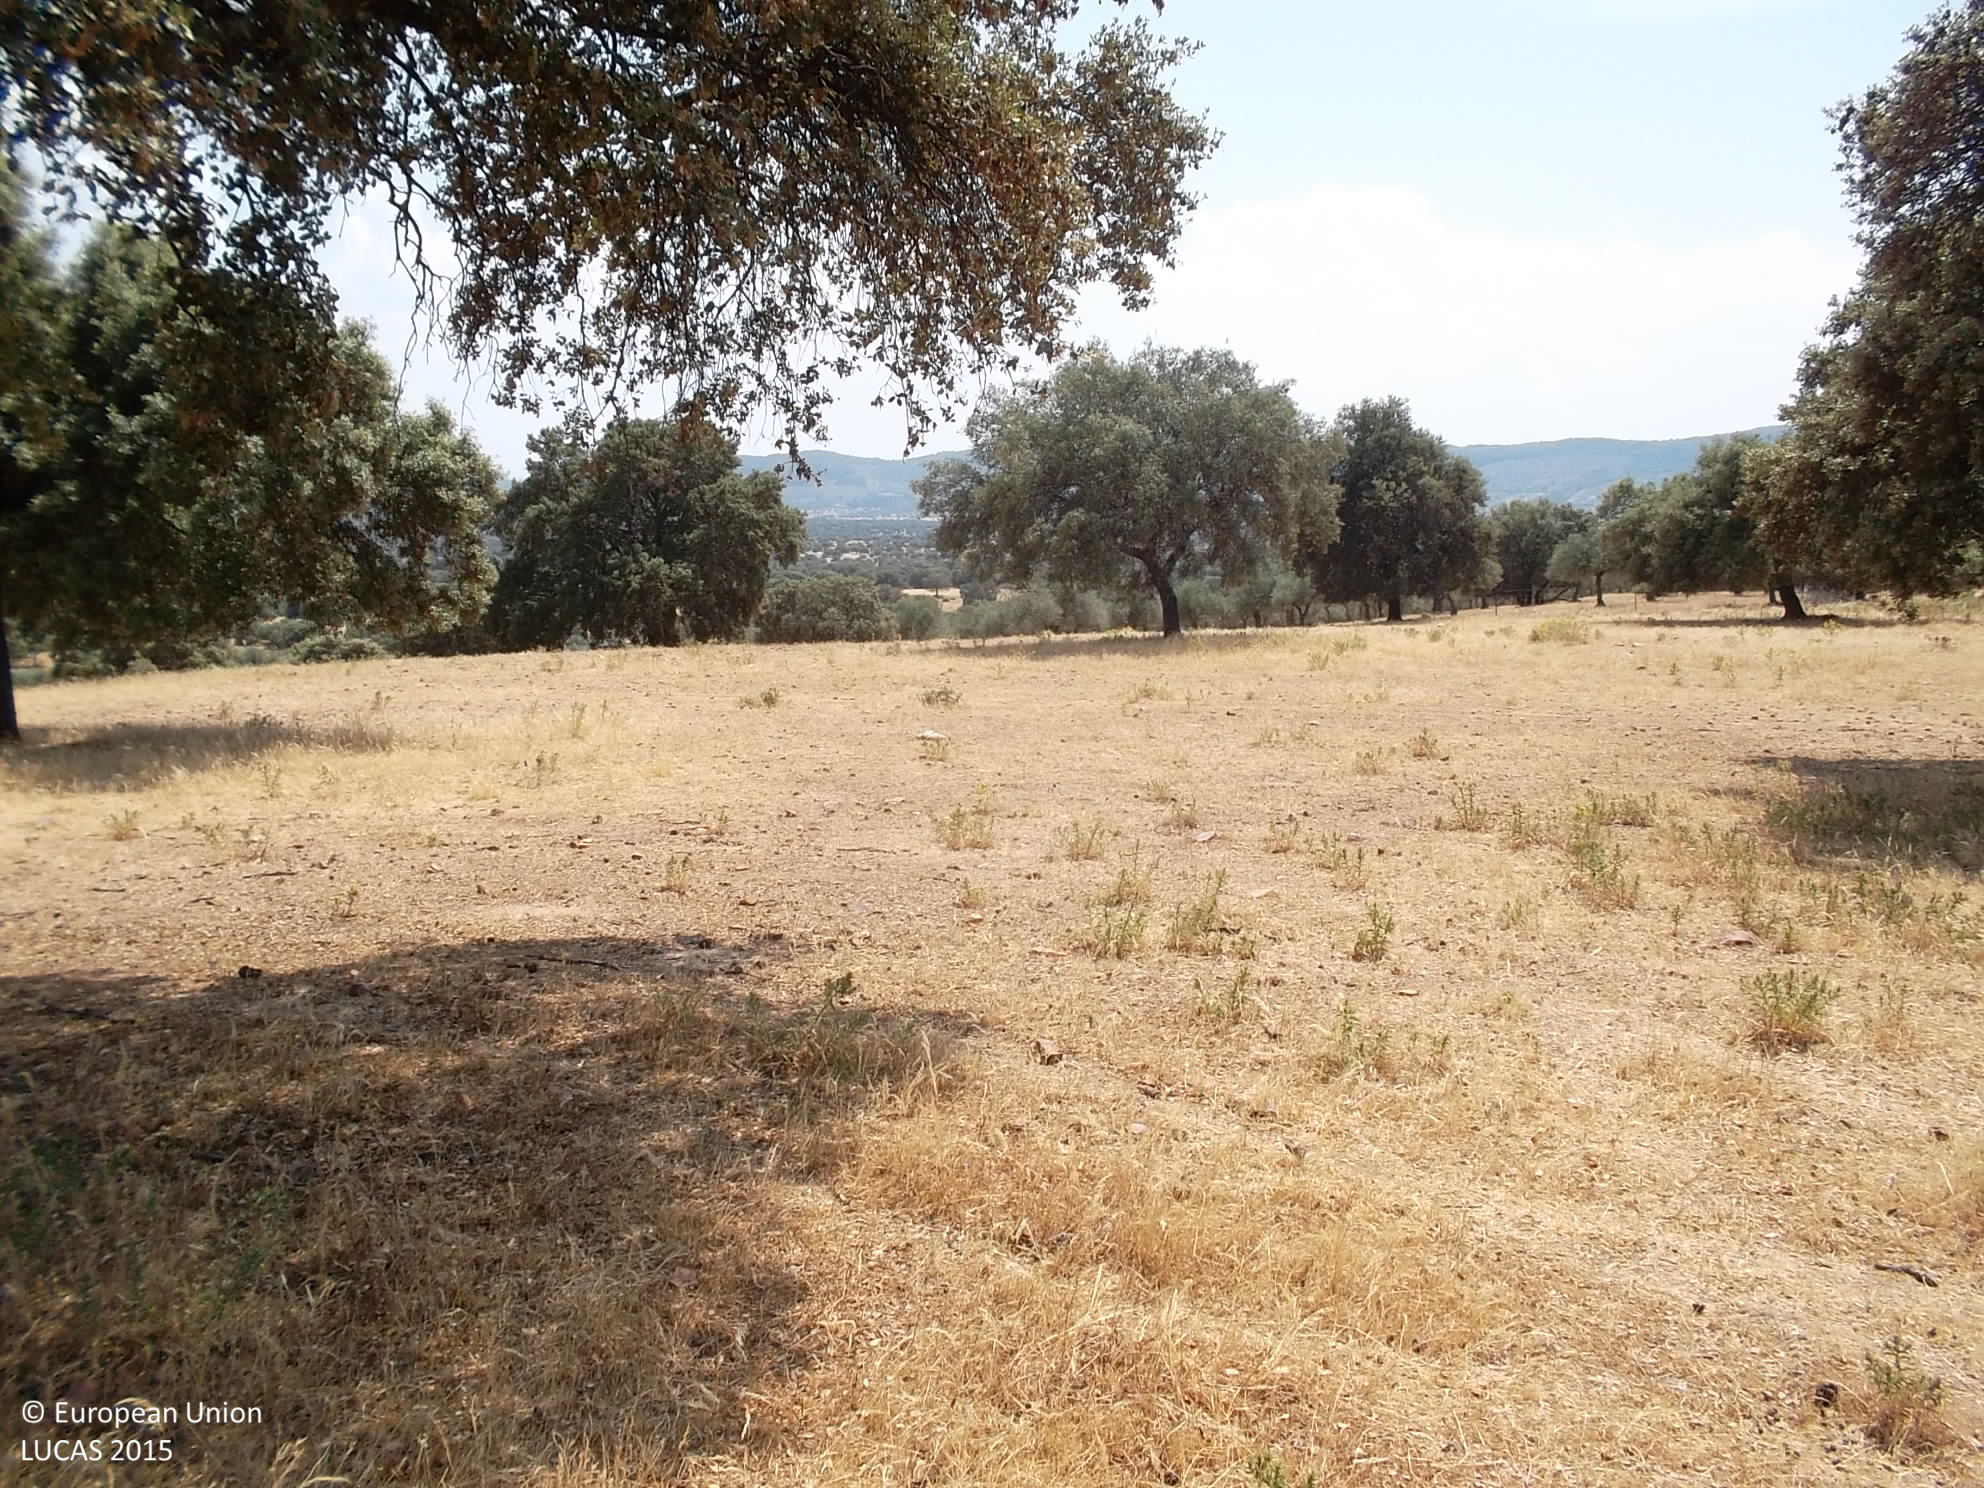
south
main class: Woodland
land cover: Broadleaved woodland
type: broadleaved evergreen forest
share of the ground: 25 - 50 %
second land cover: Spontaneously vegetated surfaces
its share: > 75 %
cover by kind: broadleaved forest trees 50 %, herbaceous plants 50 %
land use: Forestry
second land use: Agriculture (excluding fallow land and kitchen gardens)
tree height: > 5 m
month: June
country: ES
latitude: 39.1864
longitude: -4.9609
